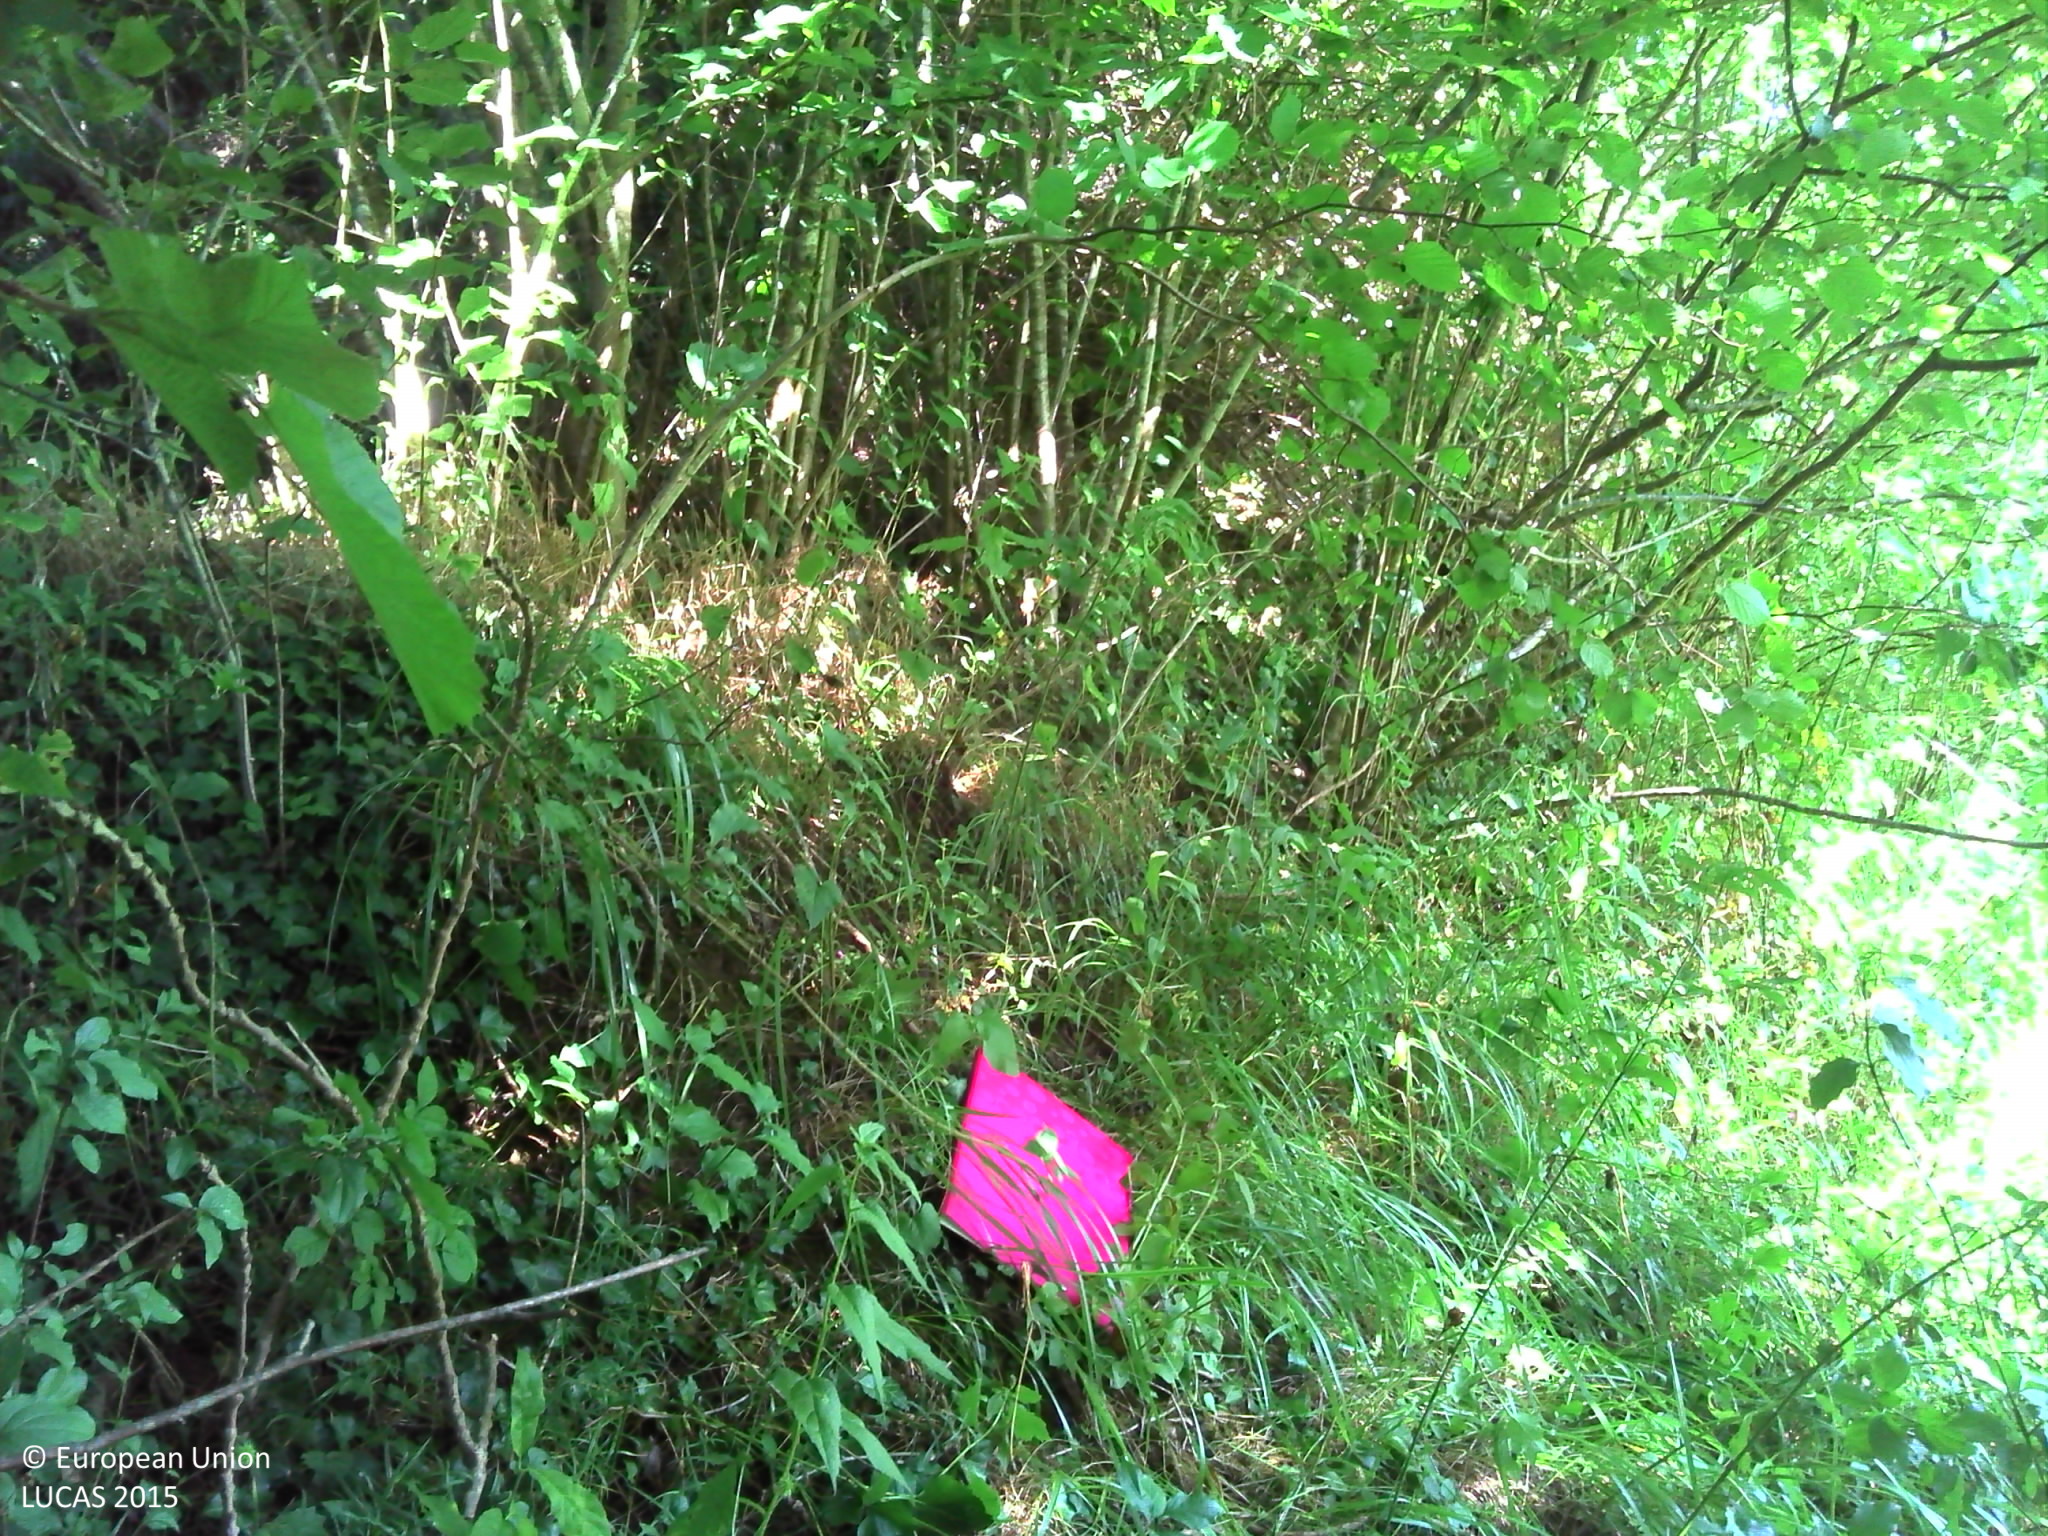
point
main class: Woodland
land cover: Broadleaved woodland
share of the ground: > 75 %
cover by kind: broadleaved forest trees 55 %, herbaceous plants 35 %, shrubs 10 %
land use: Agriculture (excluding fallow land and kitchen gardens)
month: July
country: FR
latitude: 42.9885
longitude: -0.4174
